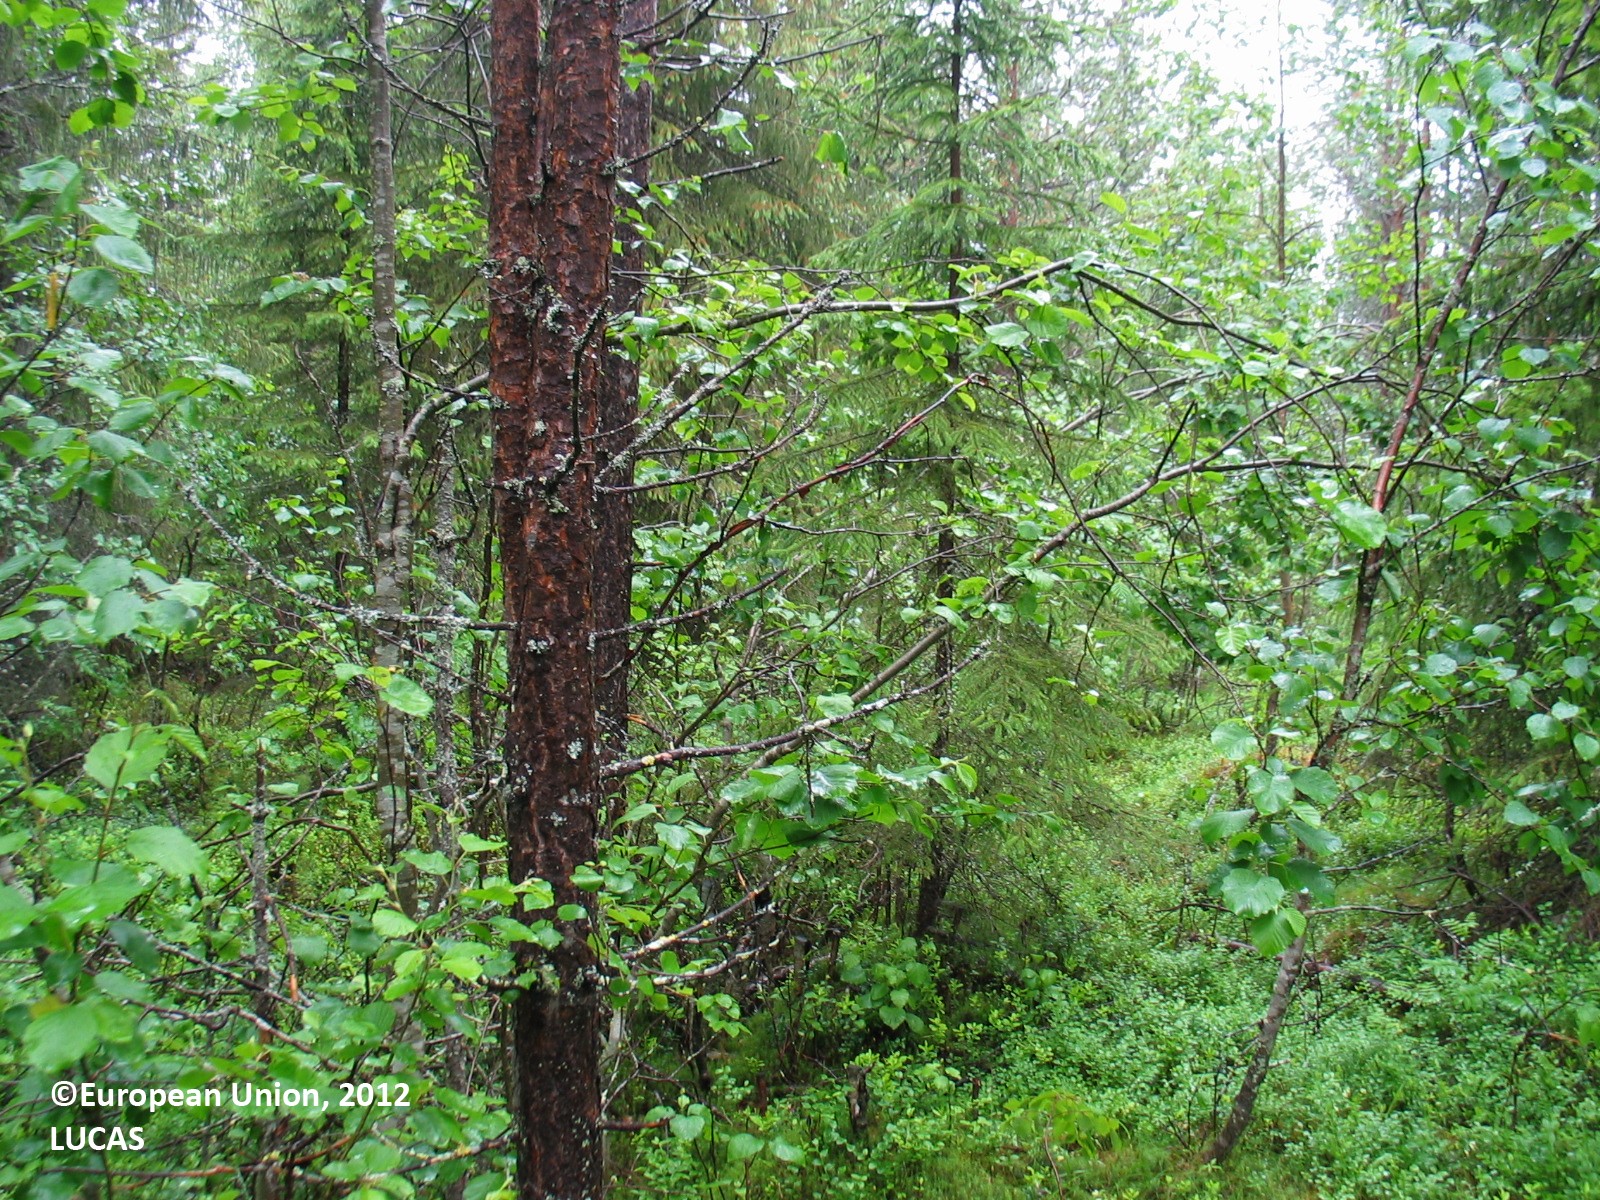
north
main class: Woodland
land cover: Pine dominated coniferous woodland
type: boreal forest
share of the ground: 25 - 50 %
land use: Forestry
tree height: > 5 m
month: July
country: FI
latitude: 66.0384
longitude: 24.8639
